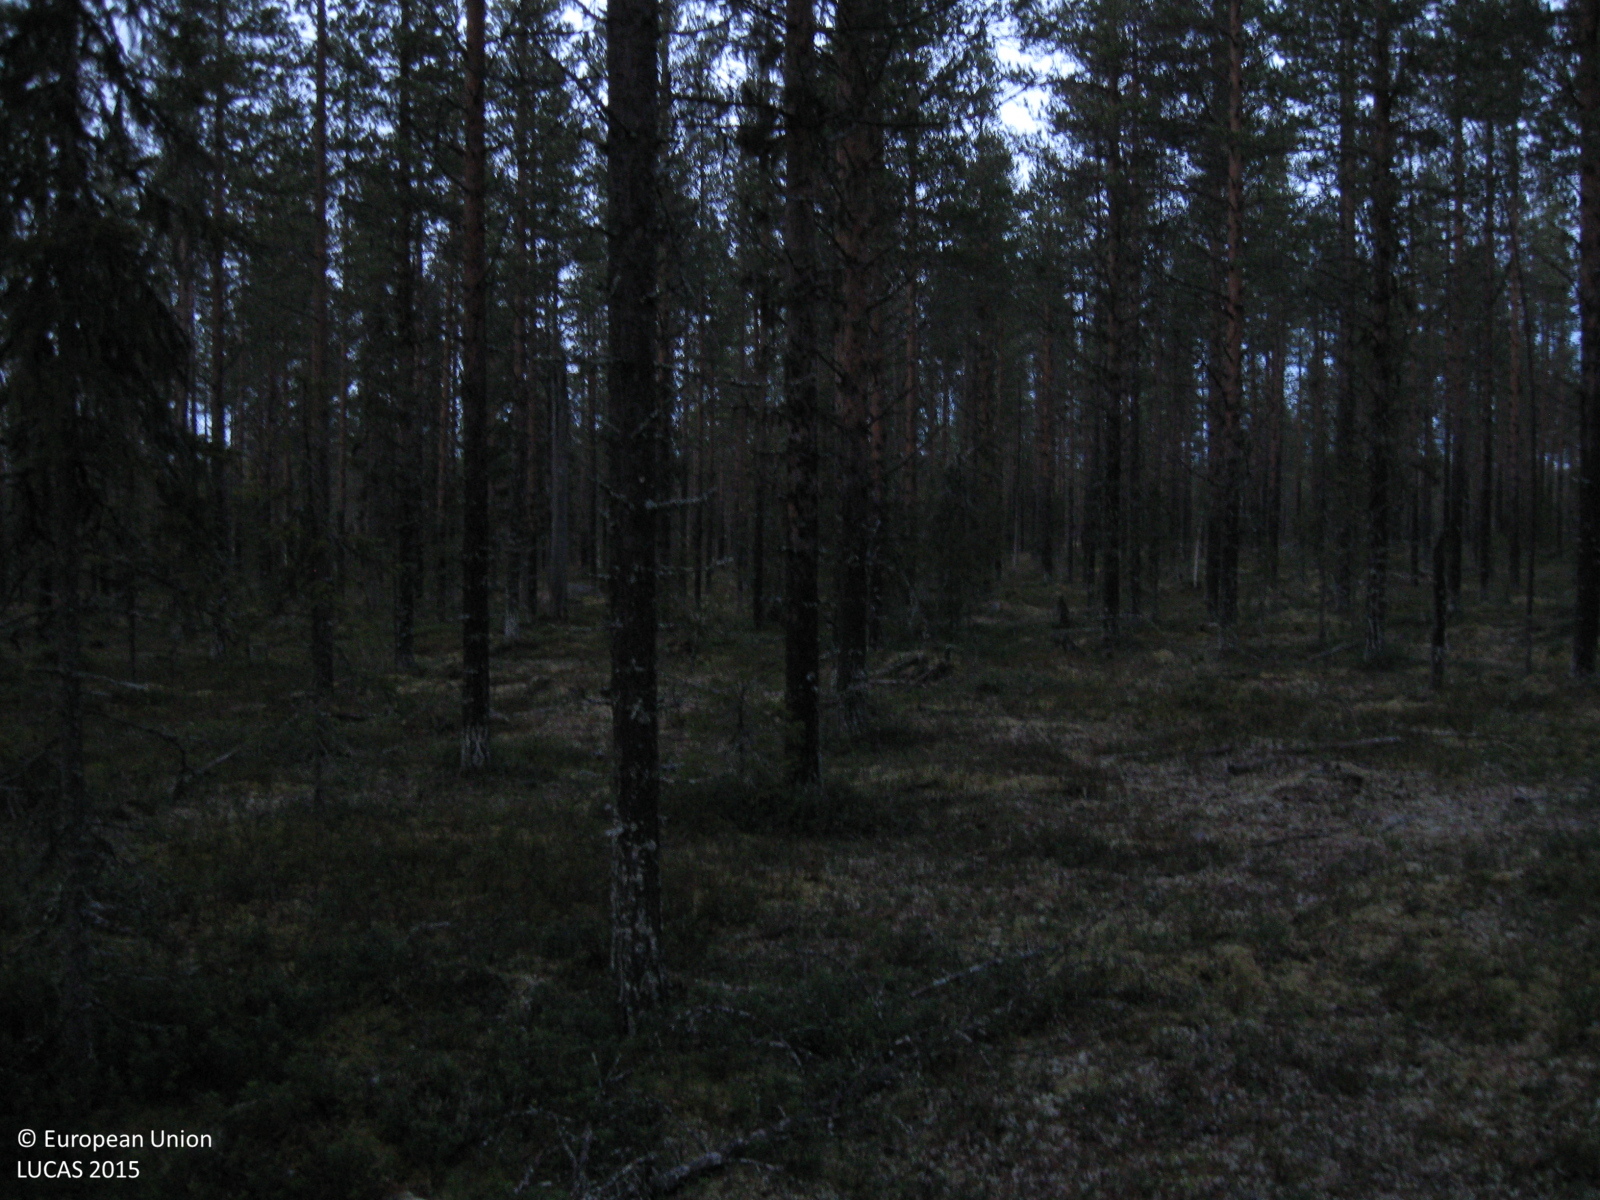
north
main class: Woodland
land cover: Pine dominated coniferous woodland
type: boreal forest
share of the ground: > 75 %
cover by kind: coniferous forest trees 75 %, shrubs 10 %, lichens and mosses 10 %, herbaceous plants 5 %
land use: Forestry
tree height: > 5 m
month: October
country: SE
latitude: 66.5502
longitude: 21.1062
